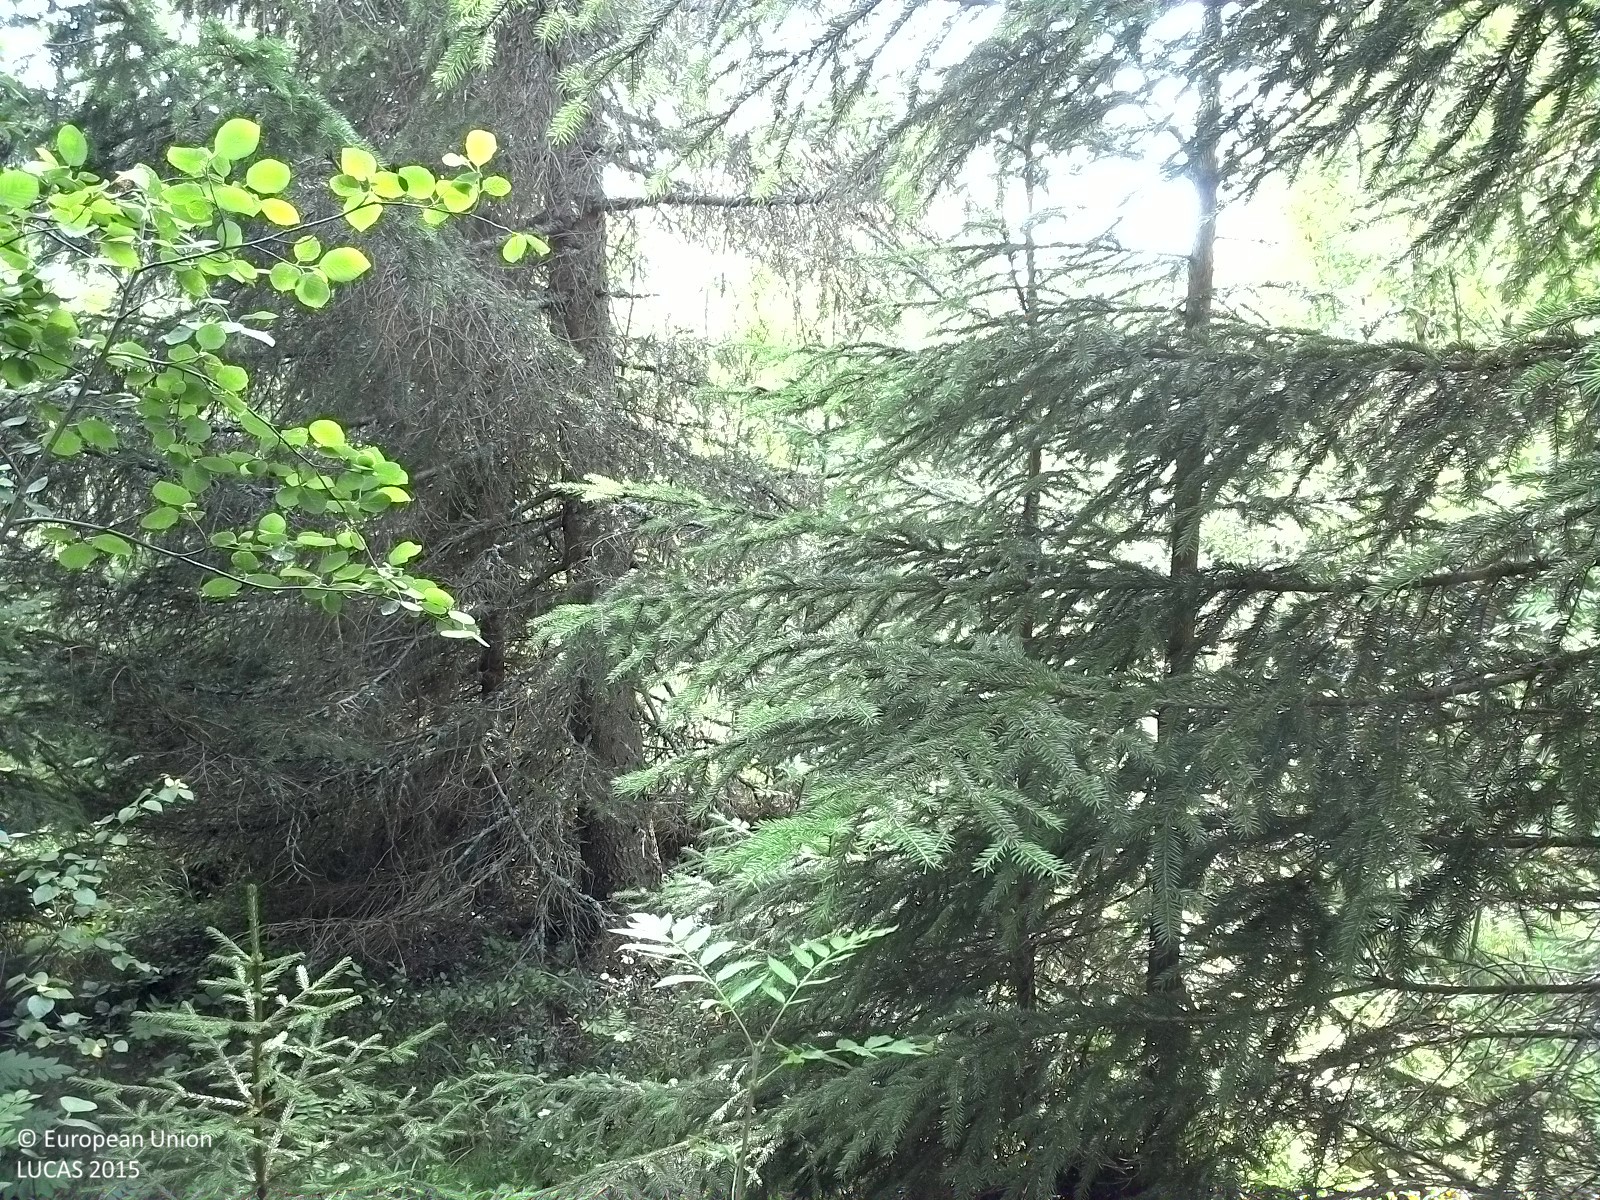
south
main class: Woodland
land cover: Other mixed woodland
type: boreal forest
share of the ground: > 75 %
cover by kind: broadleaved forest trees 50 %, coniferous forest trees 30 %, herbaceous plants 15 %, shrubs 5 %
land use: Forestry
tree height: > 5 m
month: August
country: SE
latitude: 62.3663
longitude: 17.2278
